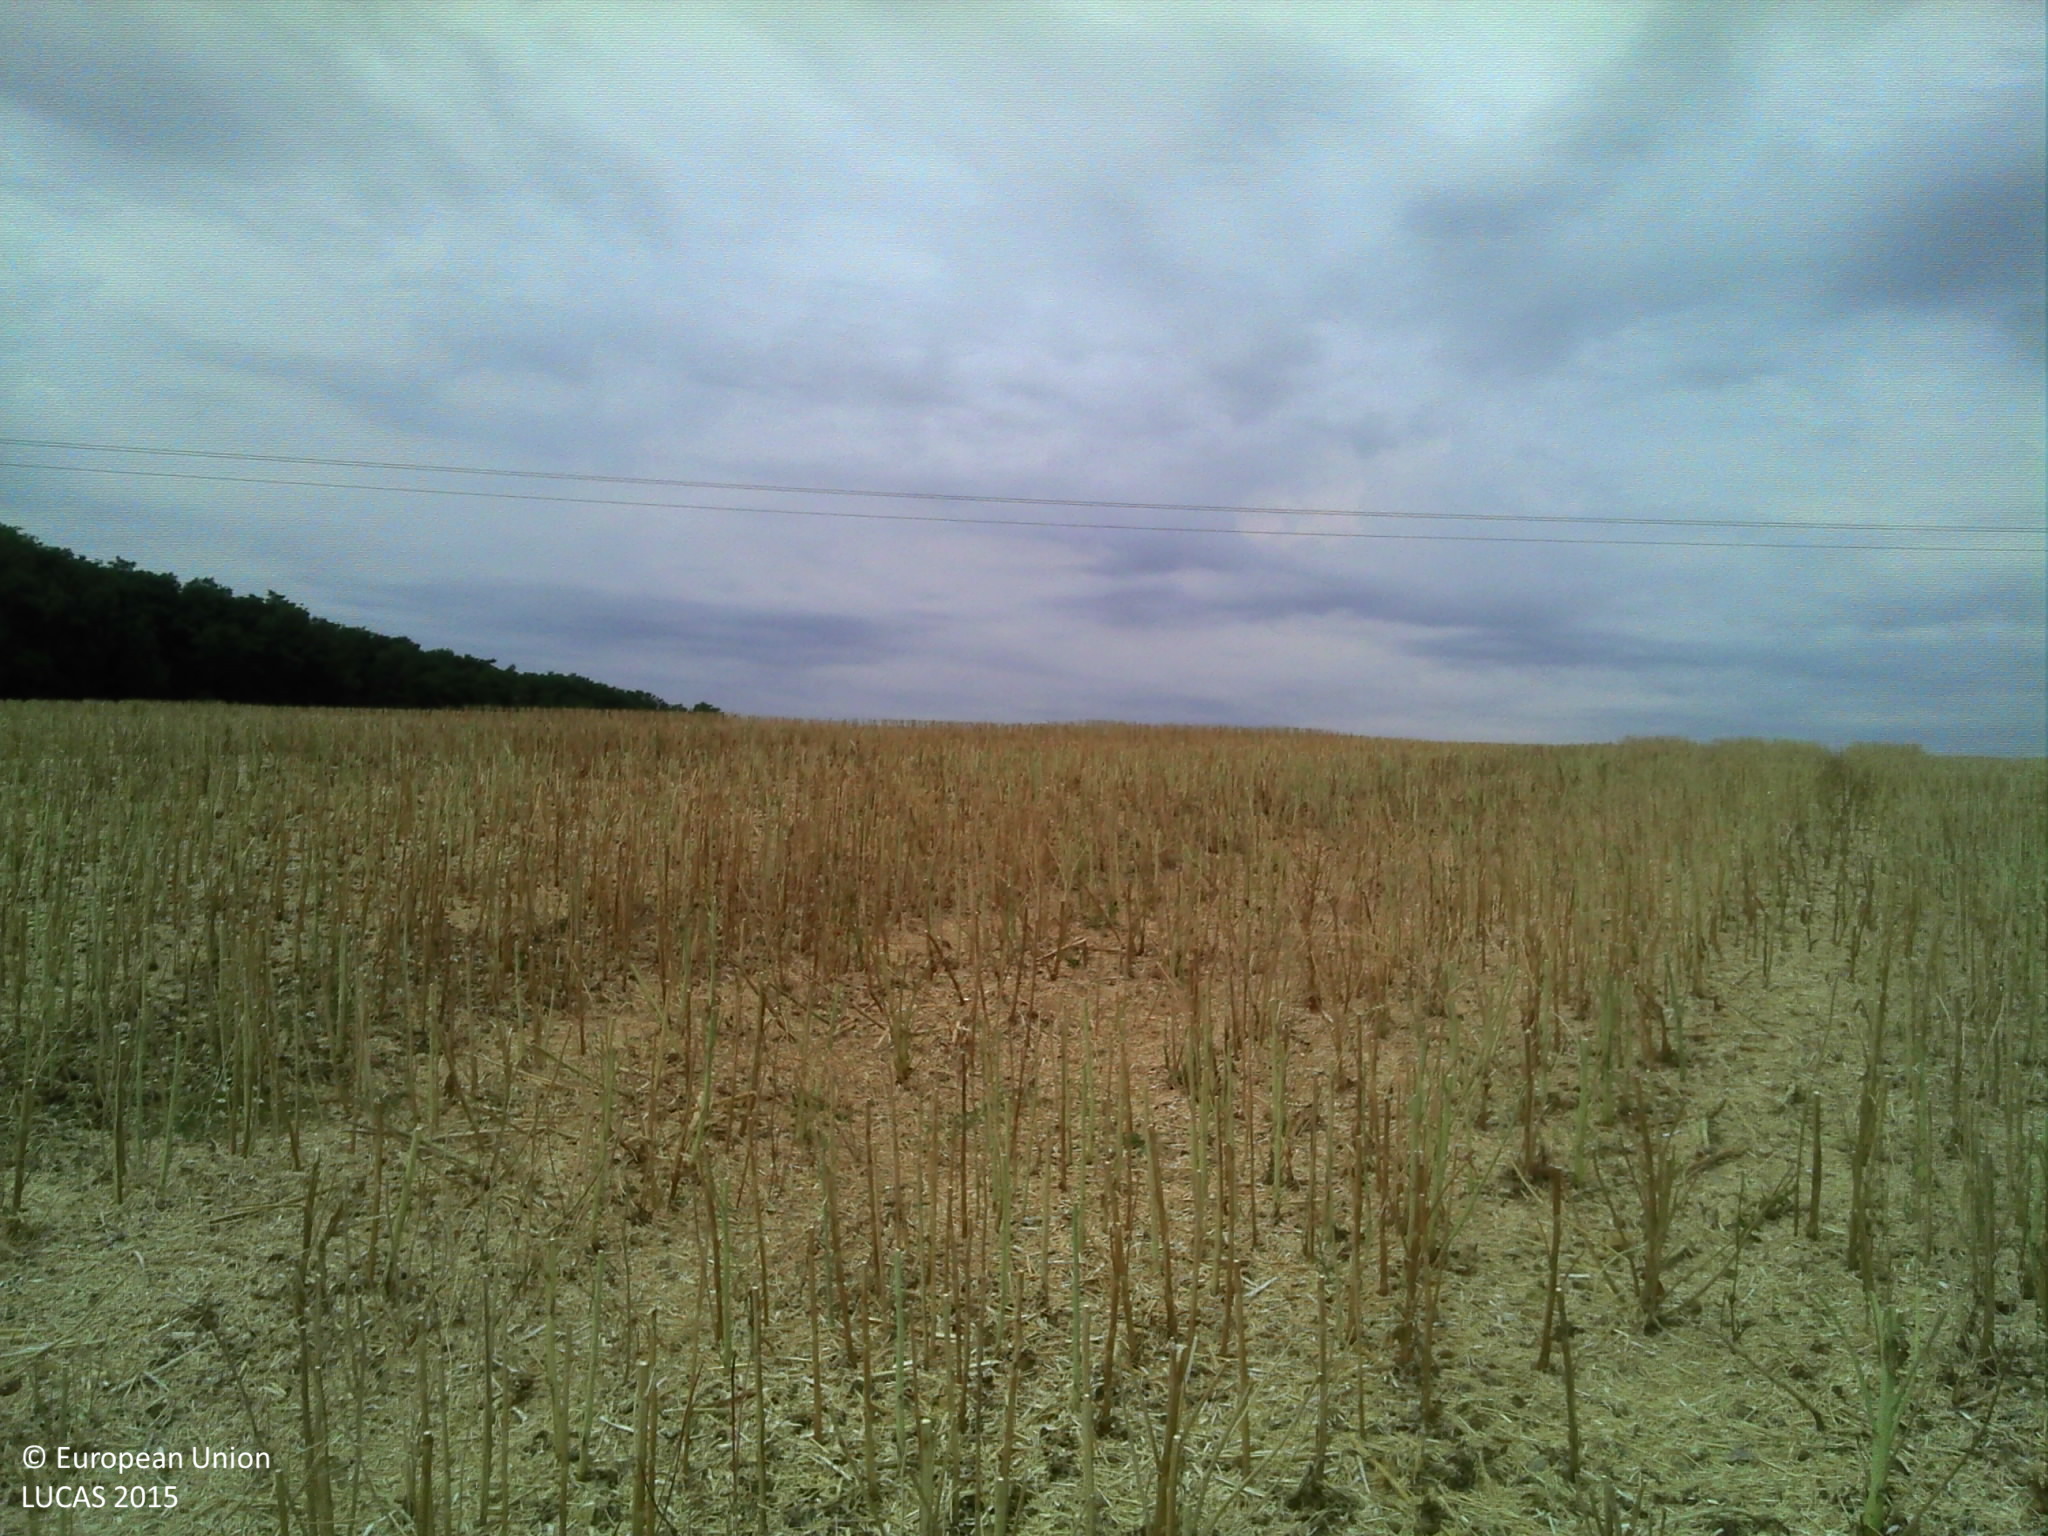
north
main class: Cropland
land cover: Rape and turnip rape
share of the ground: > 75 %
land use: Agriculture (excluding fallow land and kitchen gardens)
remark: Harvested field
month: July
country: FR
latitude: 48.1223
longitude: 3.5060
